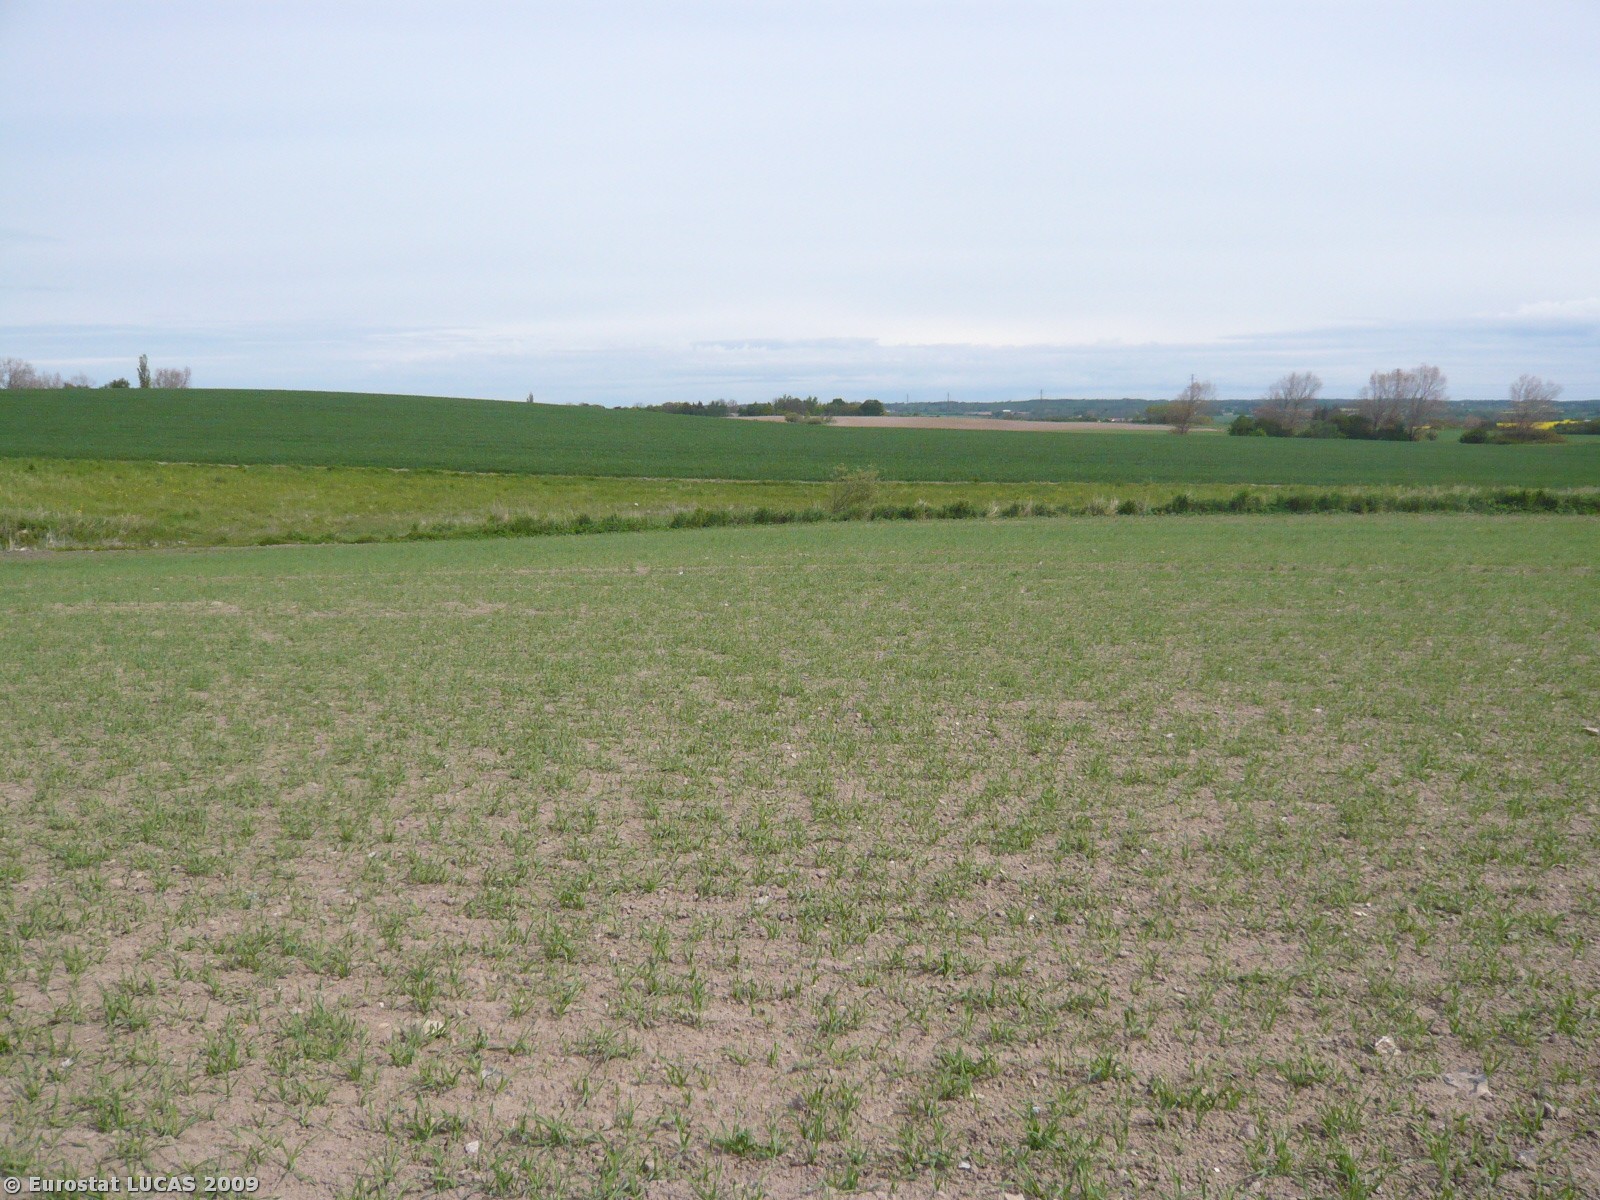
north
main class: Cropland
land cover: Common wheat
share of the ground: 25 - 50 %
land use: Agriculture (excluding fallow land and kitchen gardens)
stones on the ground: 10 - 25 %
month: May
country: DK
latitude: 55.1489
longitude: 11.8973
